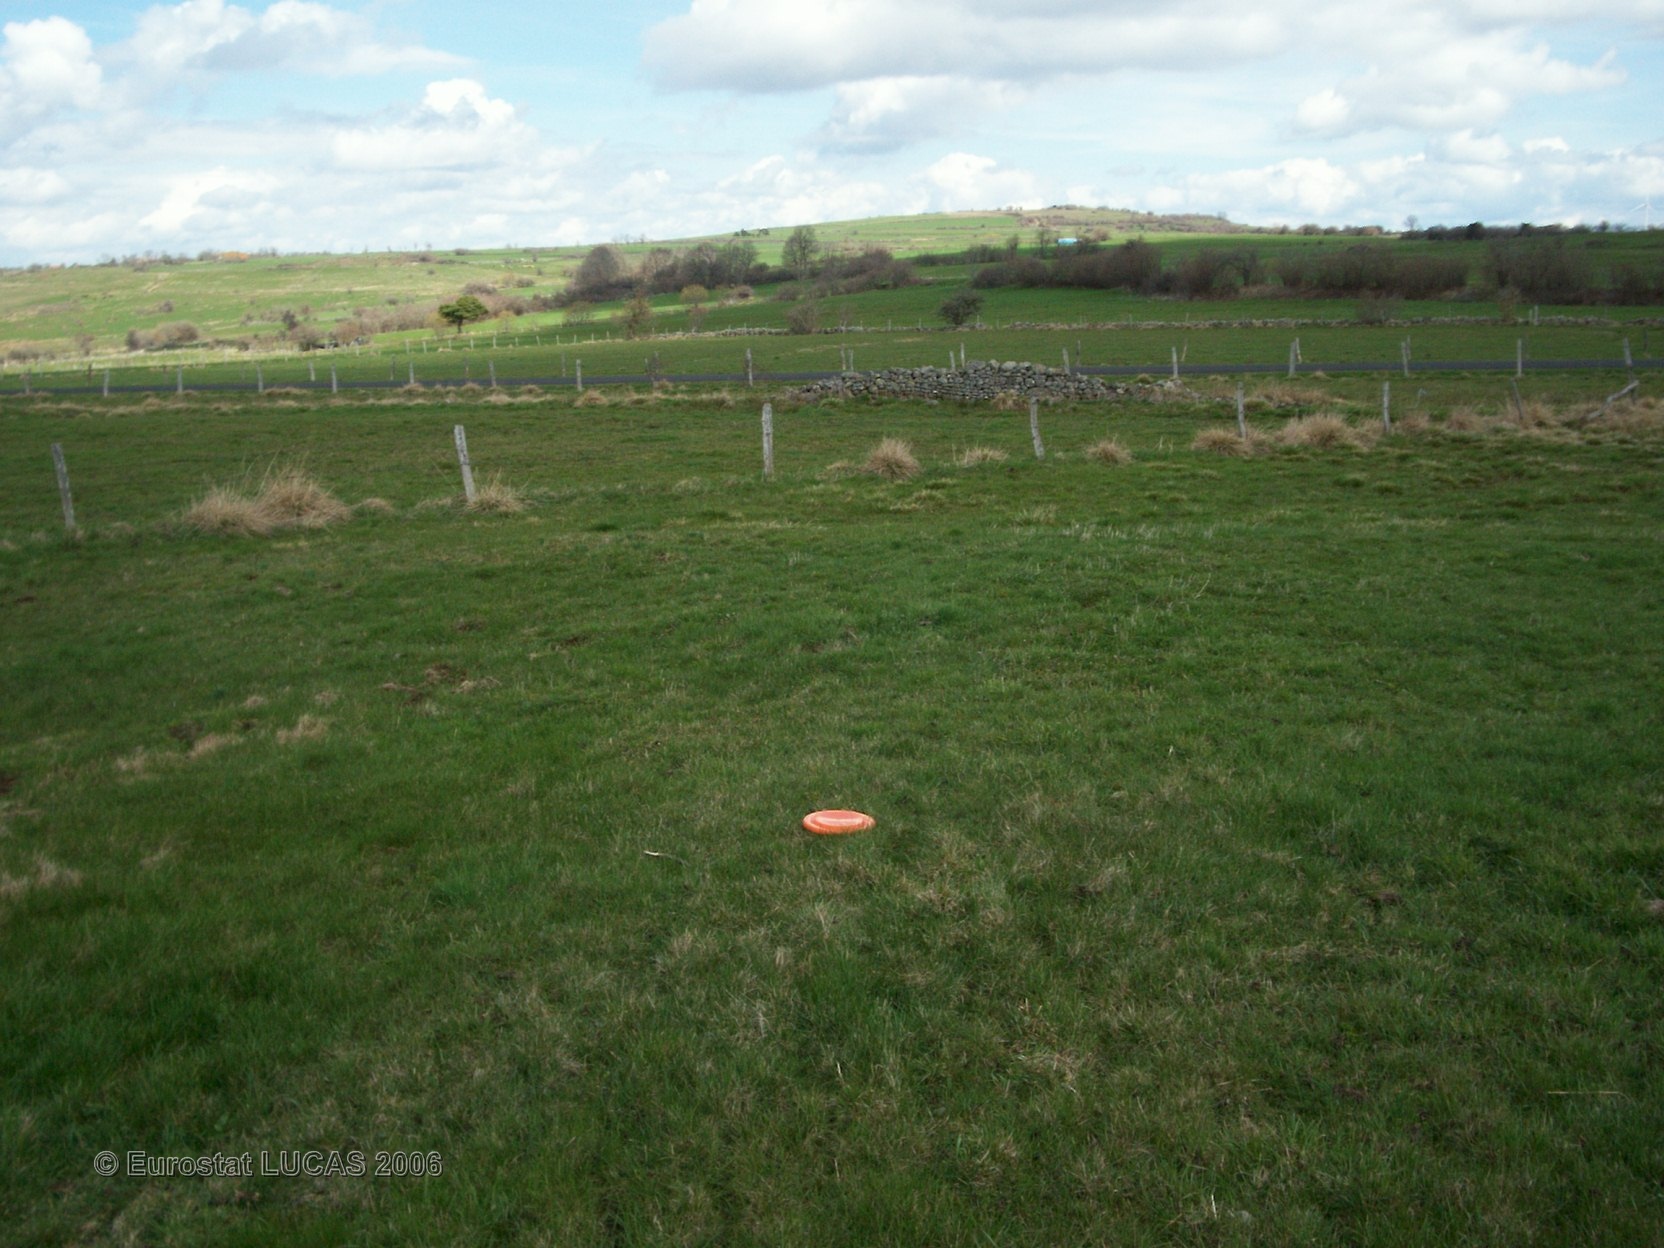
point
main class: Grassland
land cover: Grassland without tree/shrub cover
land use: Agriculture (excluding fallow land and kitchen gardens)
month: April
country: FR
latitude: 45.1077
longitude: 3.2536
